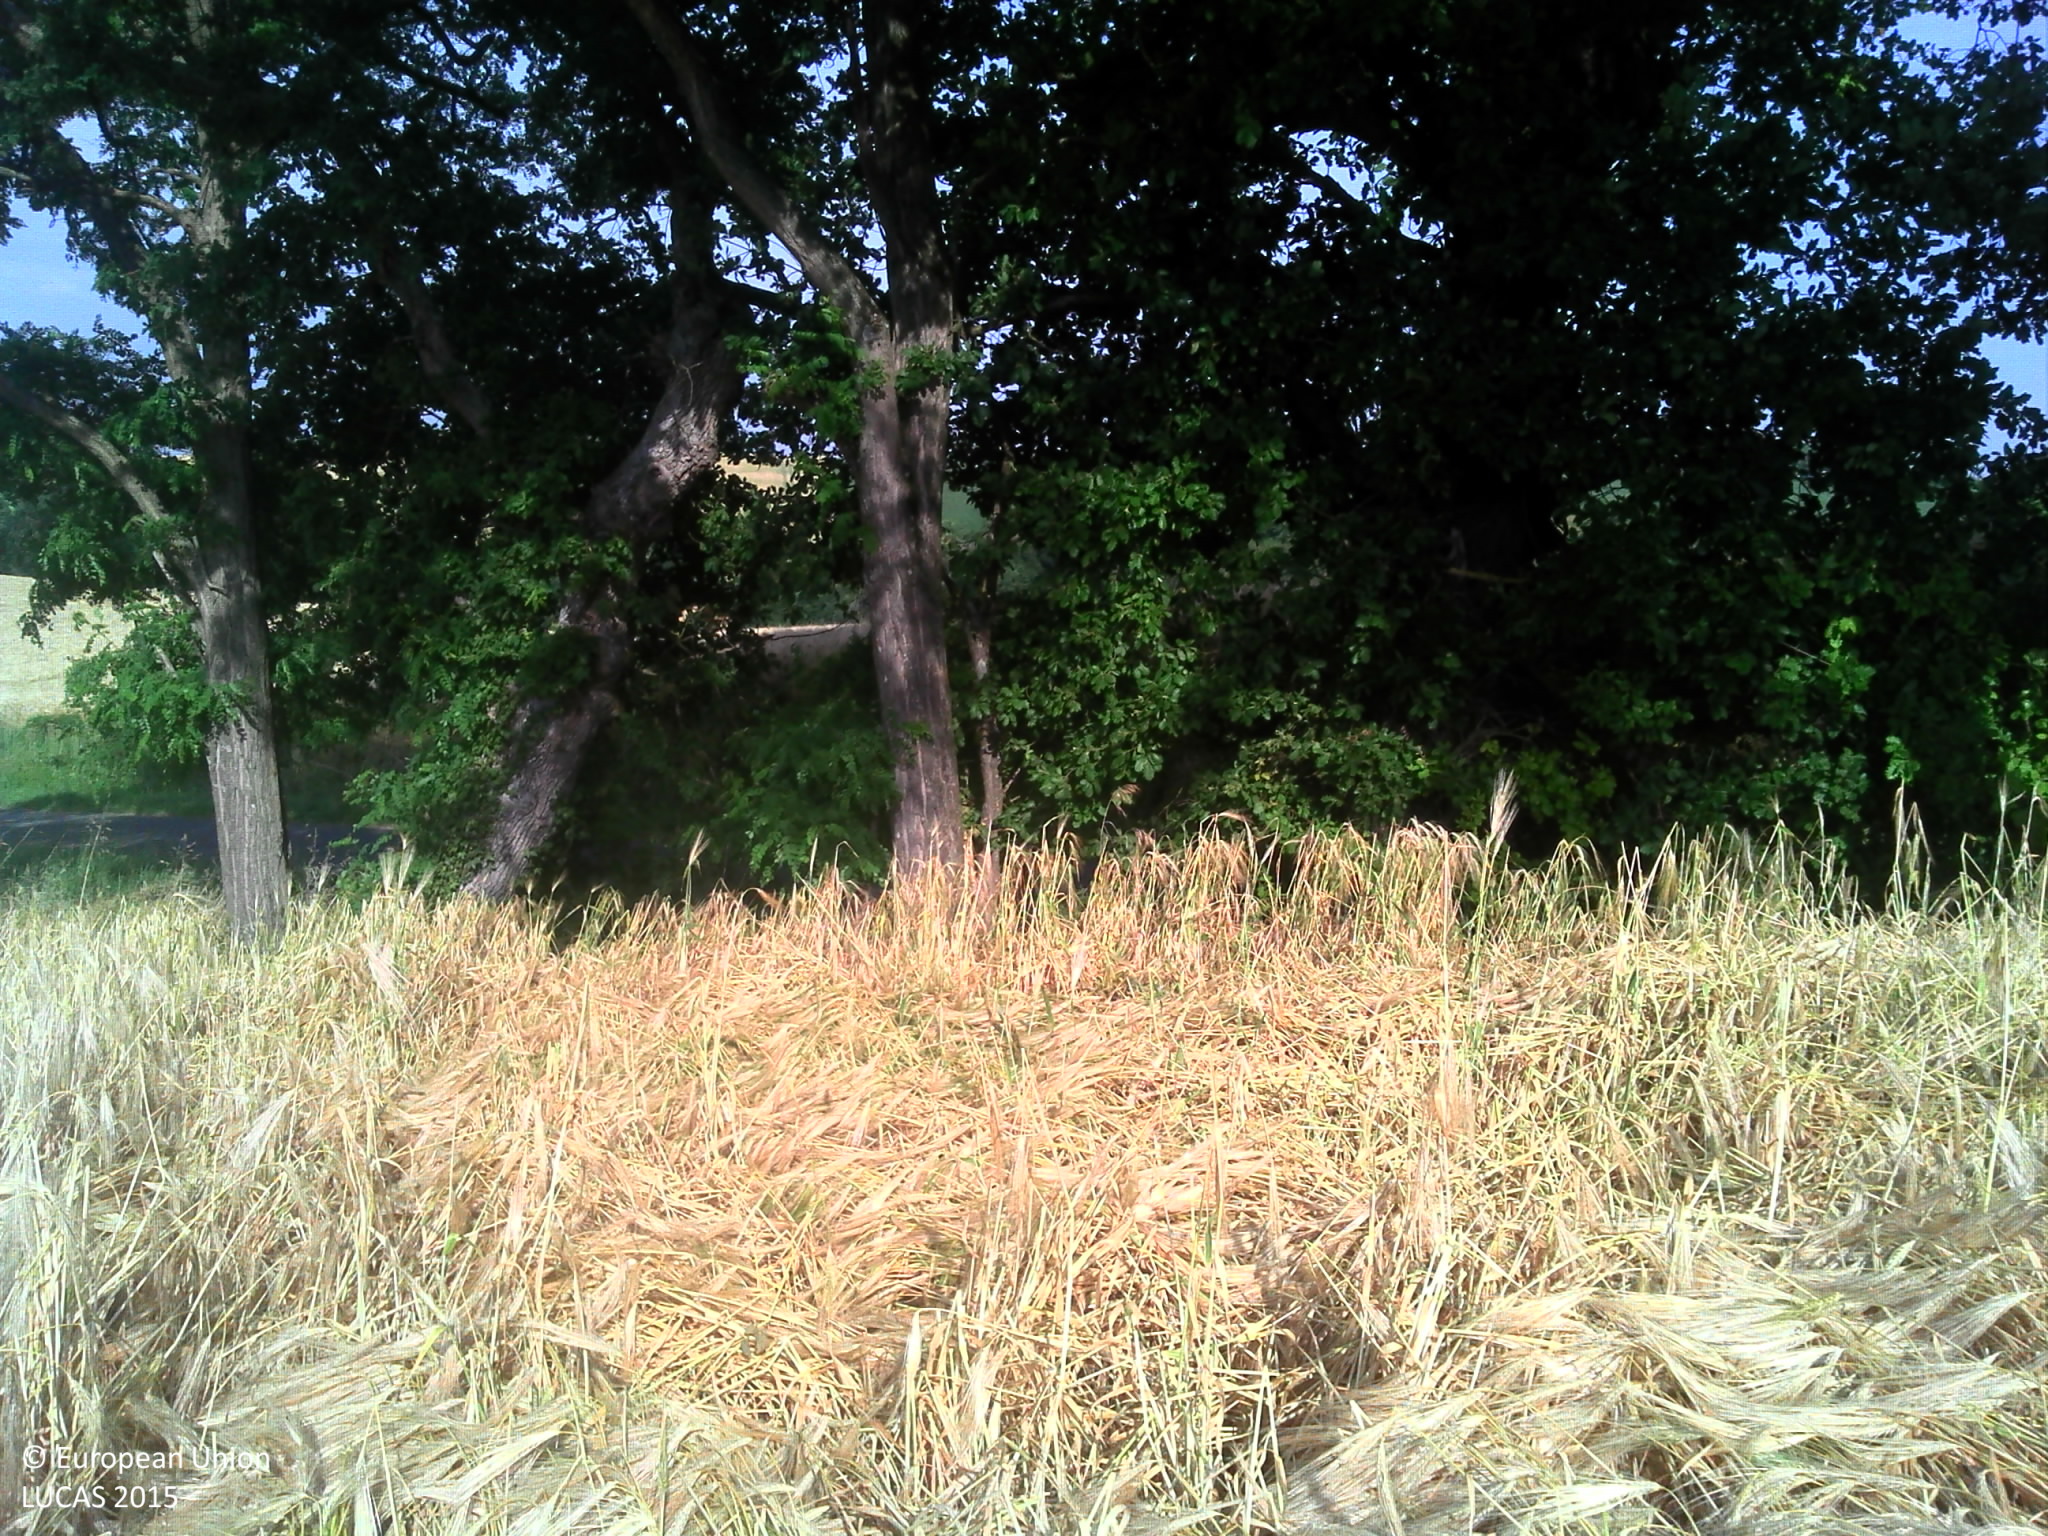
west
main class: Cropland
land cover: Barley
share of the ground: > 75 %
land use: Agriculture (excluding fallow land and kitchen gardens)
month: June
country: FR
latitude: 43.6398
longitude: 1.7355
